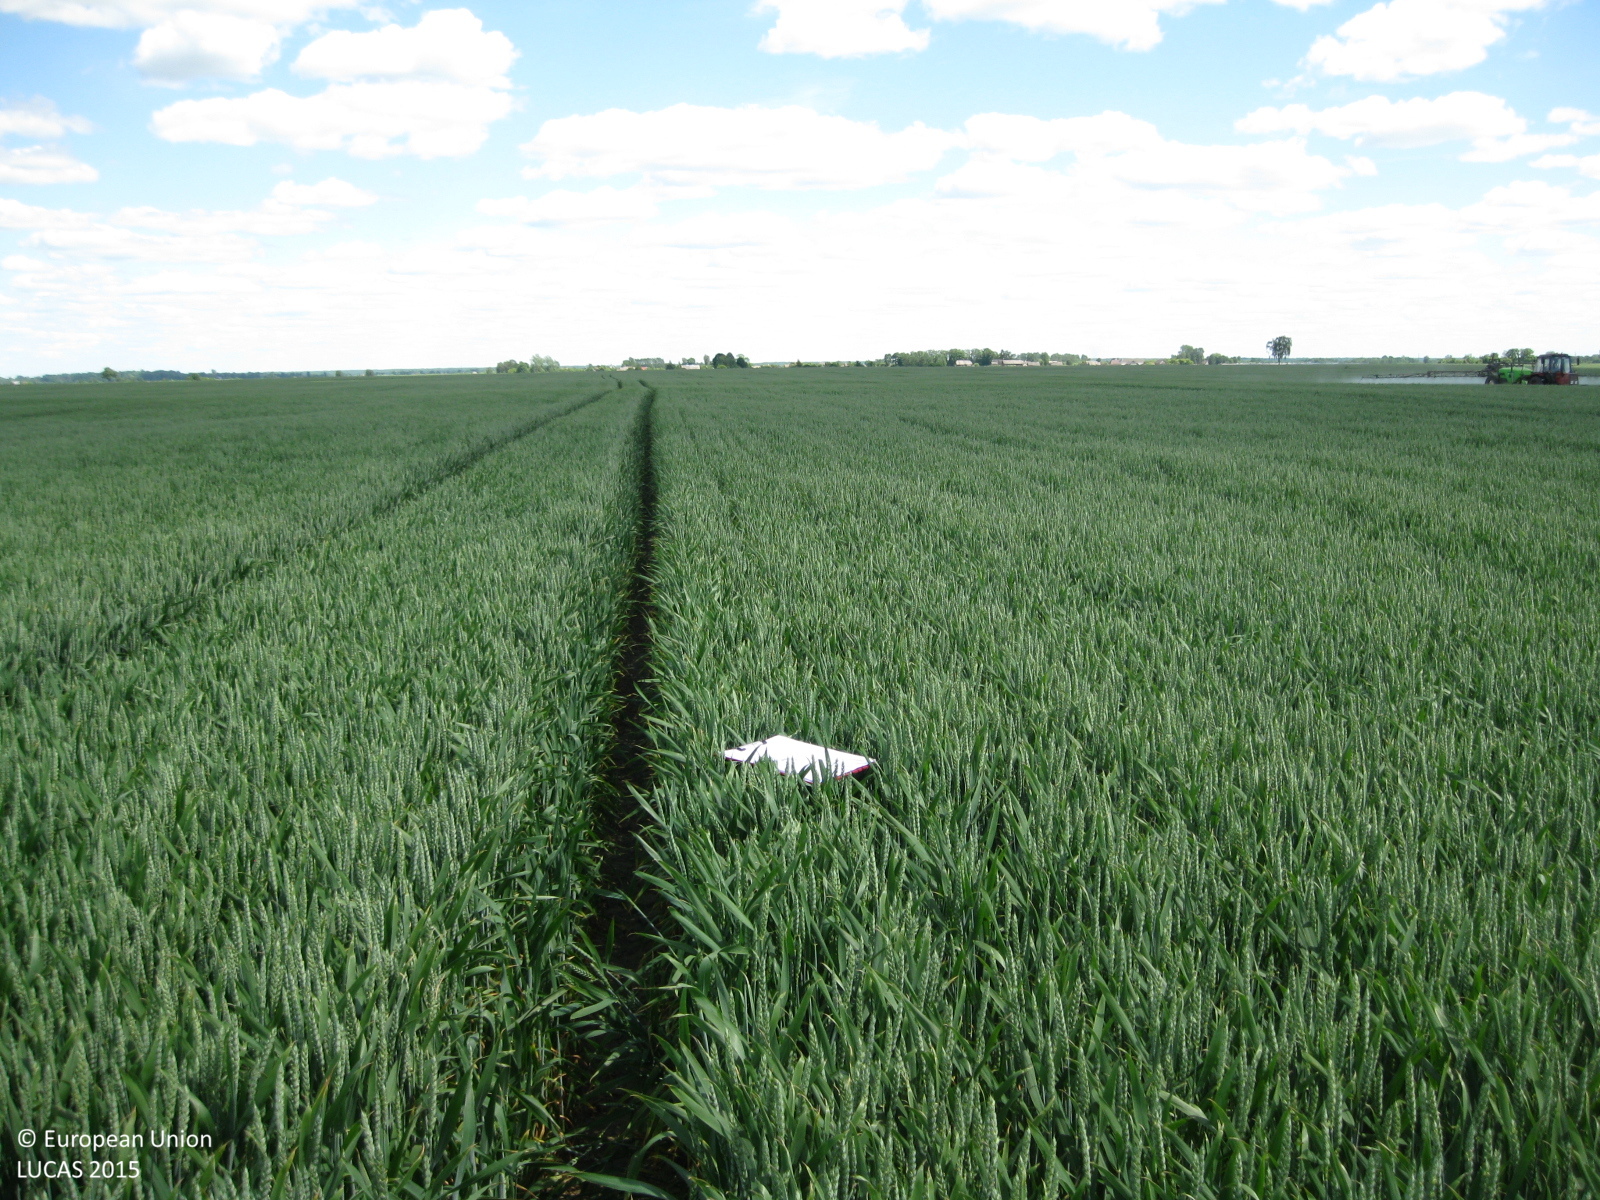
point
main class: Cropland
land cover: Common wheat
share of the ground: > 75 %
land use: Agriculture (excluding fallow land and kitchen gardens)
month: June
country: LT
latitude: 55.3861
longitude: 23.9317
